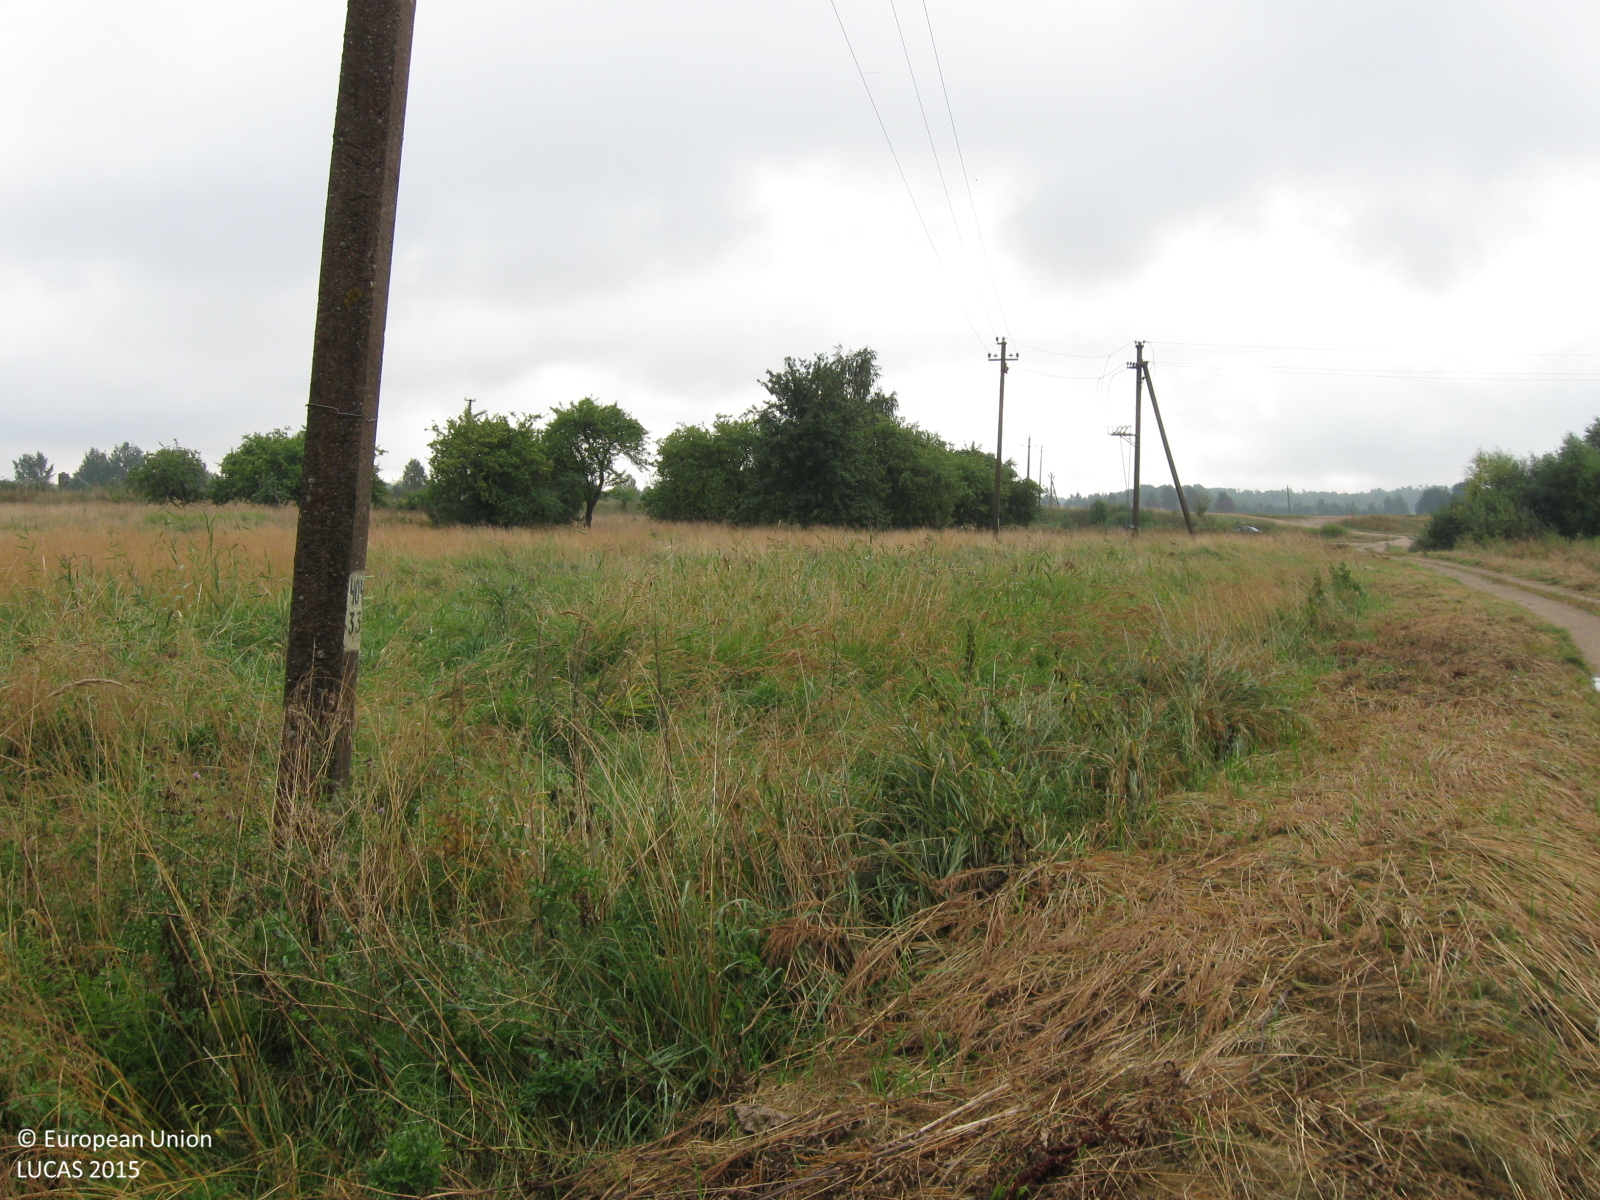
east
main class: Grassland
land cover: Spontaneously vegetated surfaces
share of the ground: > 75 %
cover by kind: herbaceous plants 95 %, consolidated bare surface 5 %
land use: Semi-natural and natural areas not in use
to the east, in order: Grass margins; Spontaneously vegetated surfaces; Electric lines; Spontaneously vegetated surfaces; Apple fruit; Spontaneously vegetated surfaces; Paved roads, cycling and walking lanes; Spontaneously vegetated surfaces; Broadleaved woodland; Ditches and canals; Broadleaved woodland
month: August
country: LT
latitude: 55.3453
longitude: 22.9525
